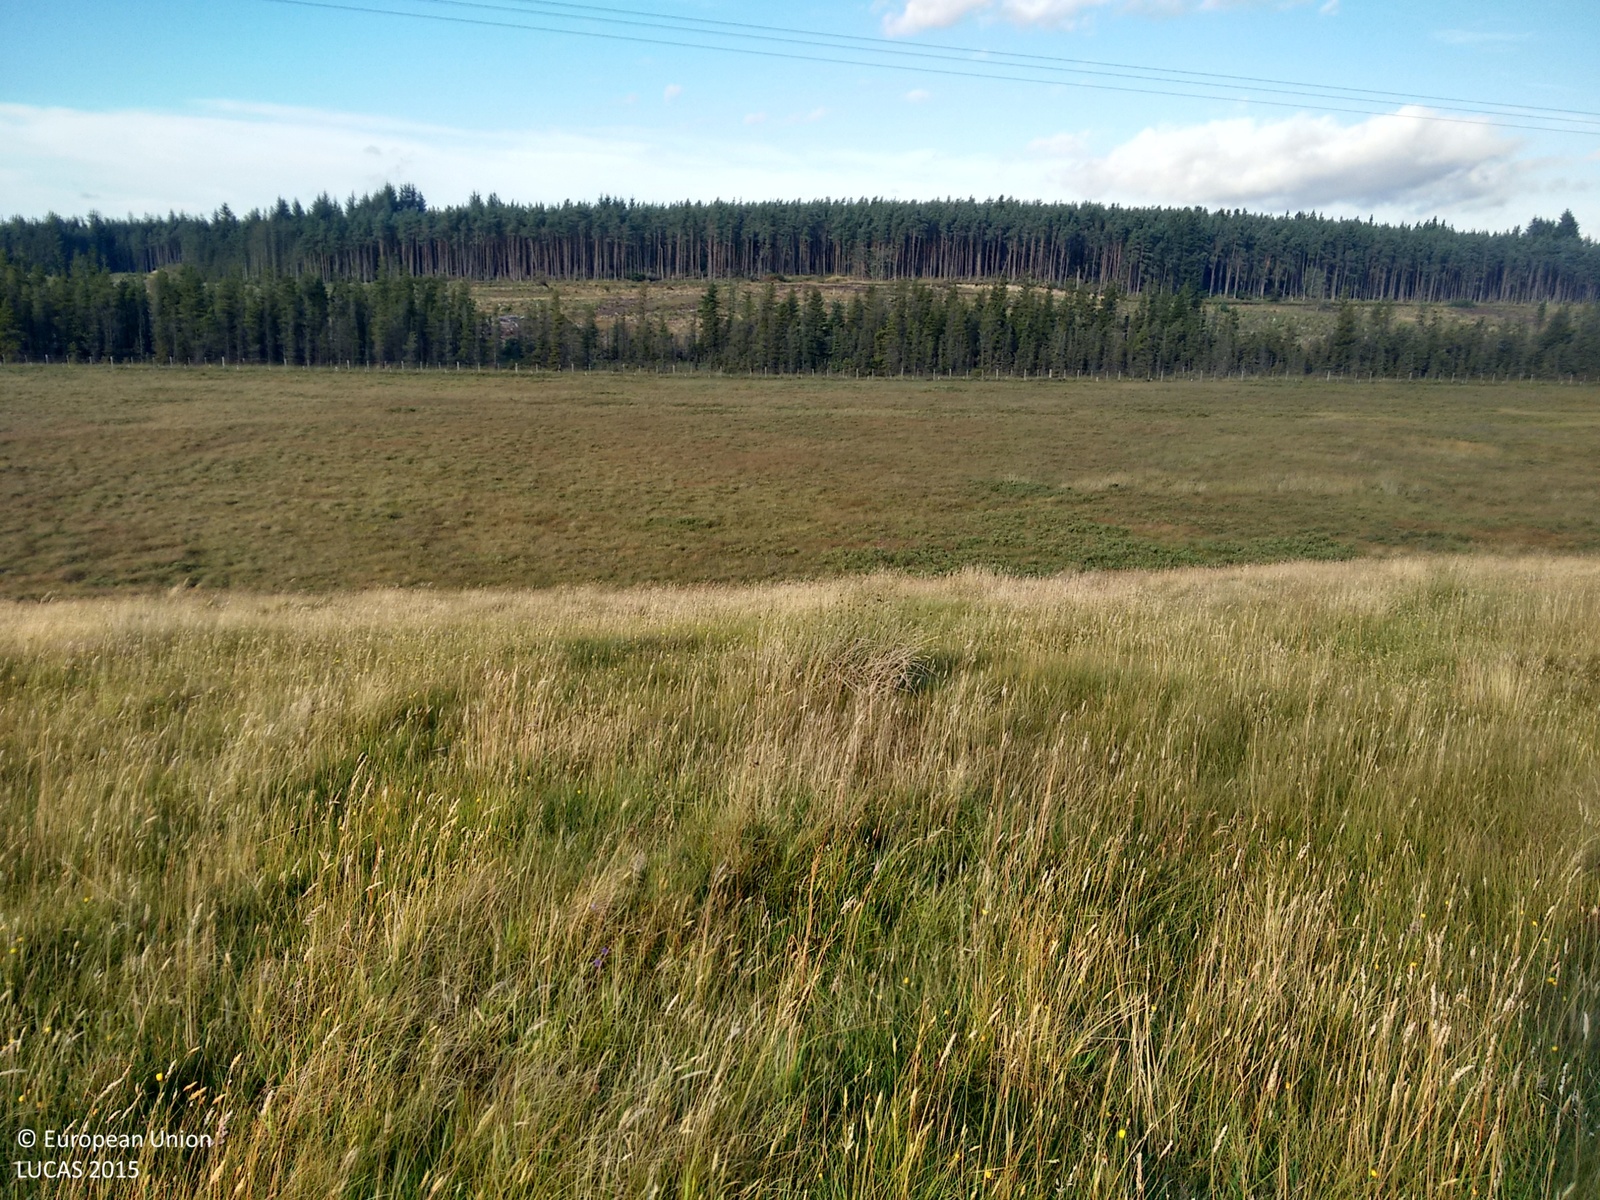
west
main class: Grassland
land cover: Grassland without tree/shrub cover
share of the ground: > 75 %
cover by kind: herbaceous plants 100 %
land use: Agriculture (excluding fallow land and kitchen gardens)
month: September
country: GB
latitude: 58.0428
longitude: -4.3996
